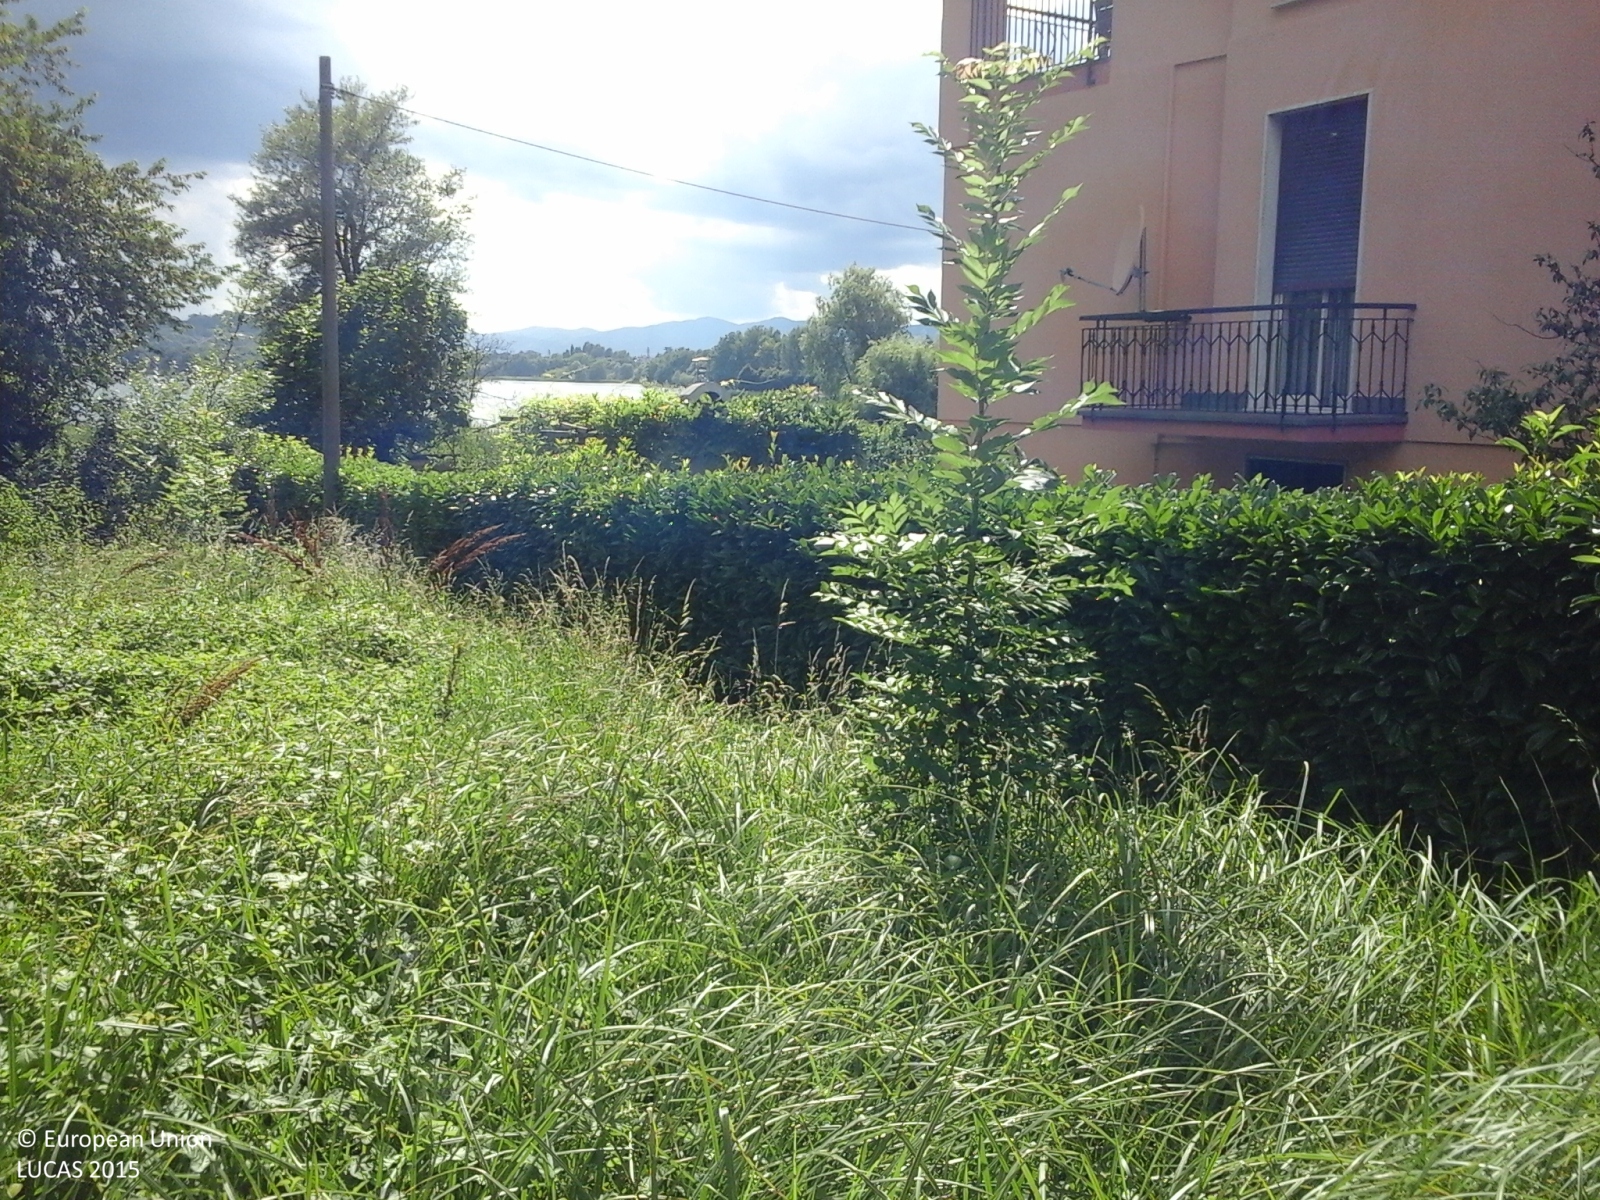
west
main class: Woodland
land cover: Broadleaved woodland
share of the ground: 50 - 75 %
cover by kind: shrubs 60 %, broadleaved forest trees 20 %, herbaceous plants 20 %
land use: Abandoned areas
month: June
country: IT
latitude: 45.8391
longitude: 8.7273
